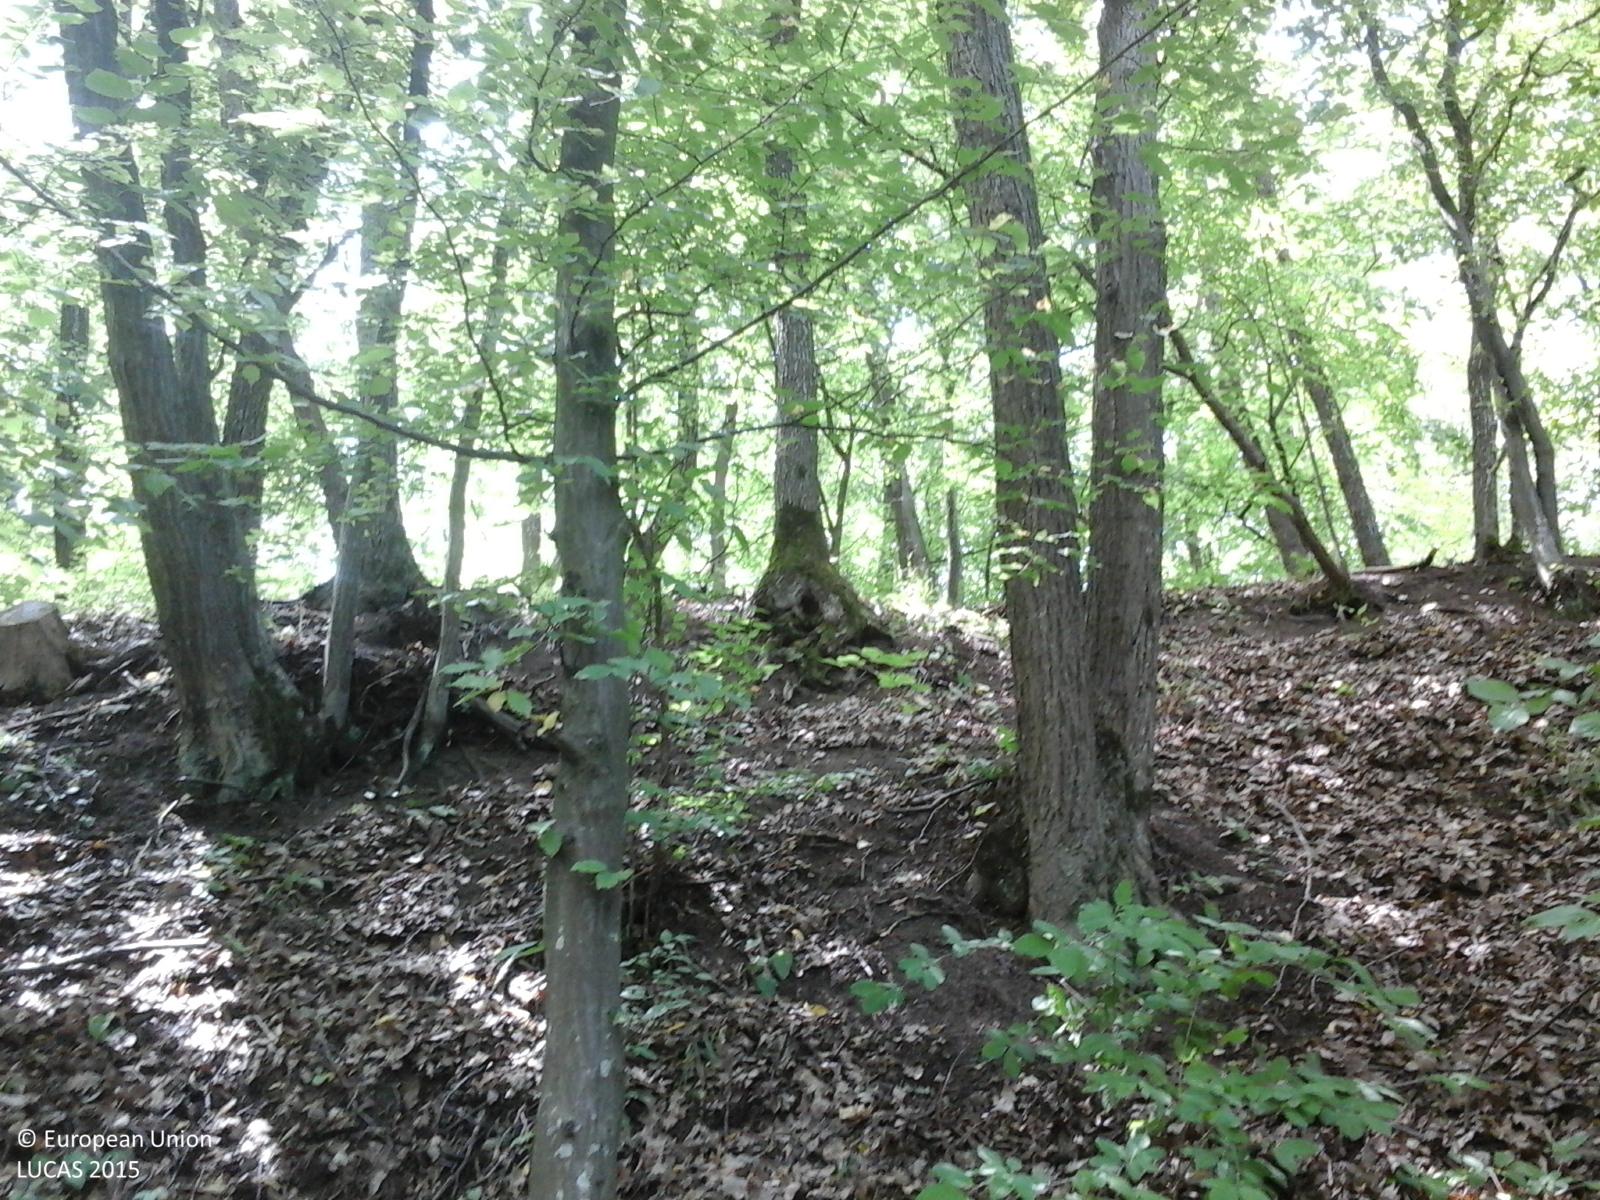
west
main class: Woodland
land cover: Broadleaved woodland
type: beech forest
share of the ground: > 75 %
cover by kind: broadleaved forest trees 95 %, herbaceous plants 5 %
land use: Forestry
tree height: > 5 m
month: June
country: RO
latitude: 47.8932
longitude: 26.3377
